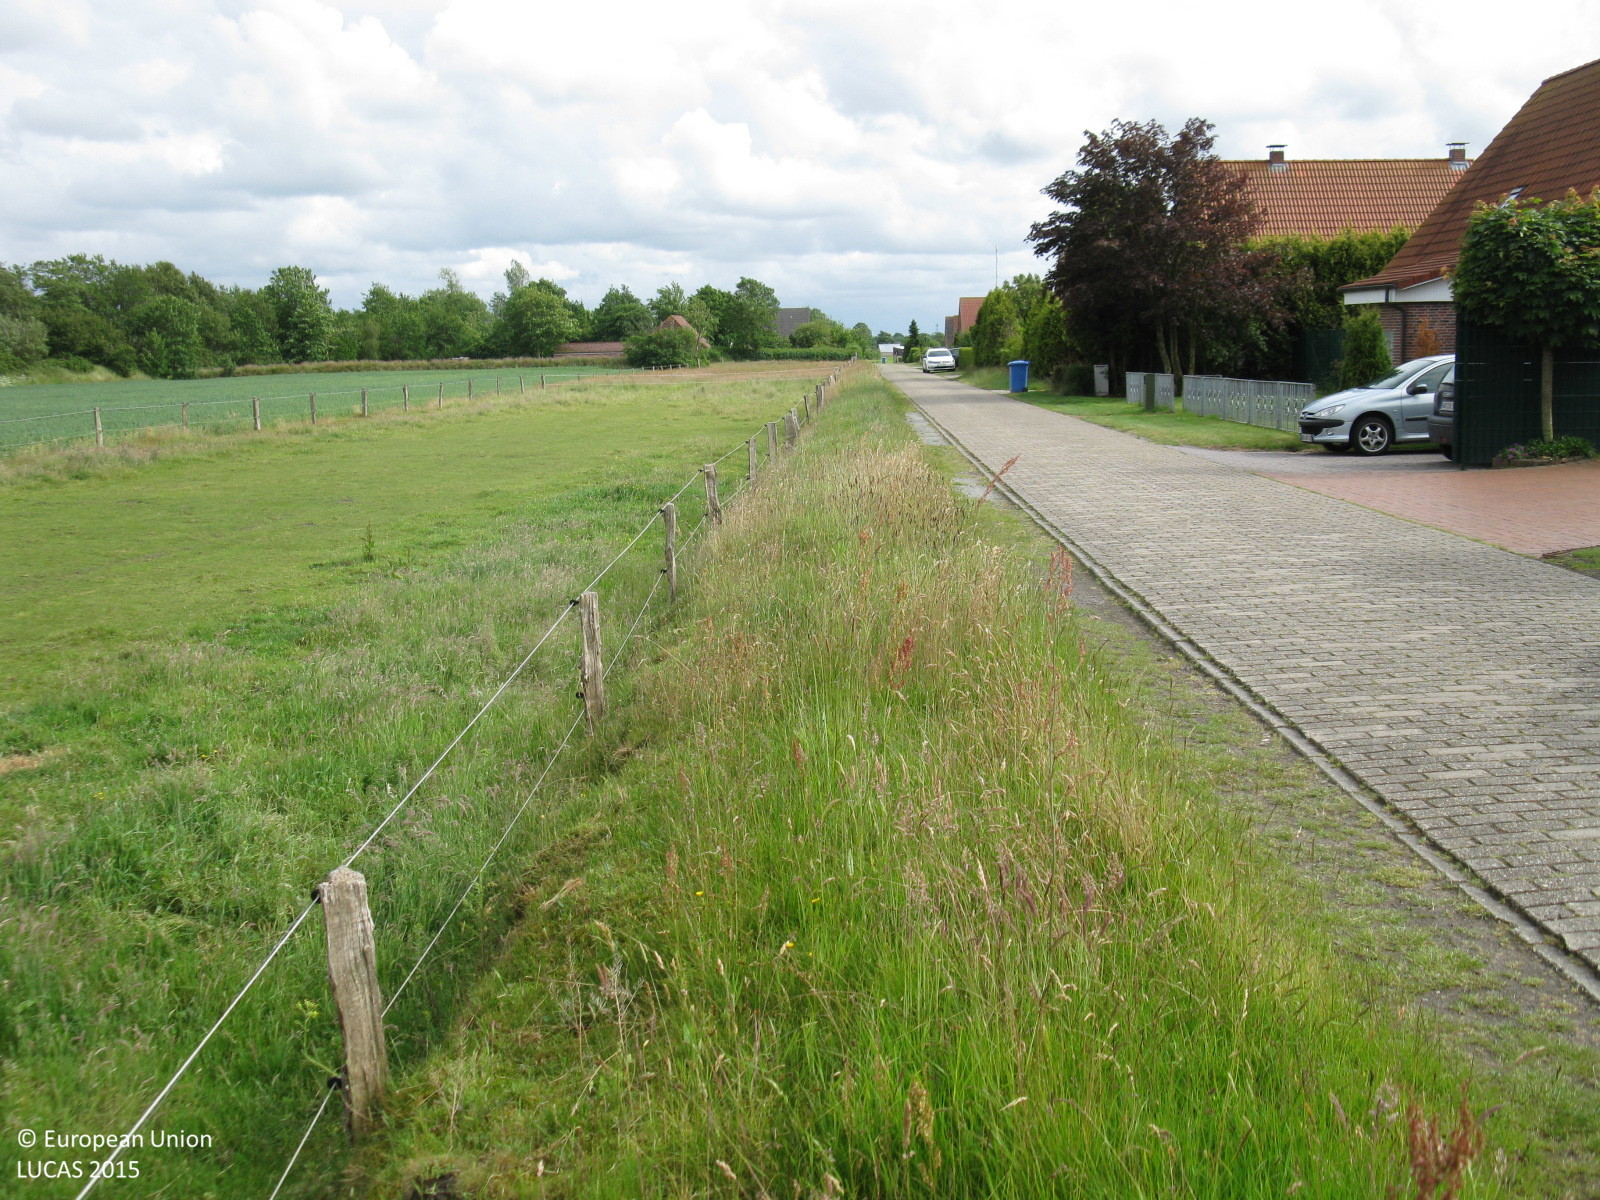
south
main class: Grassland
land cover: Grassland without tree/shrub cover
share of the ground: > 75 %
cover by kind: herbaceous plants 100 %
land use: Agriculture (excluding fallow land and kitchen gardens)
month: June
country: DE
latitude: 53.6069
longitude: 7.3558
